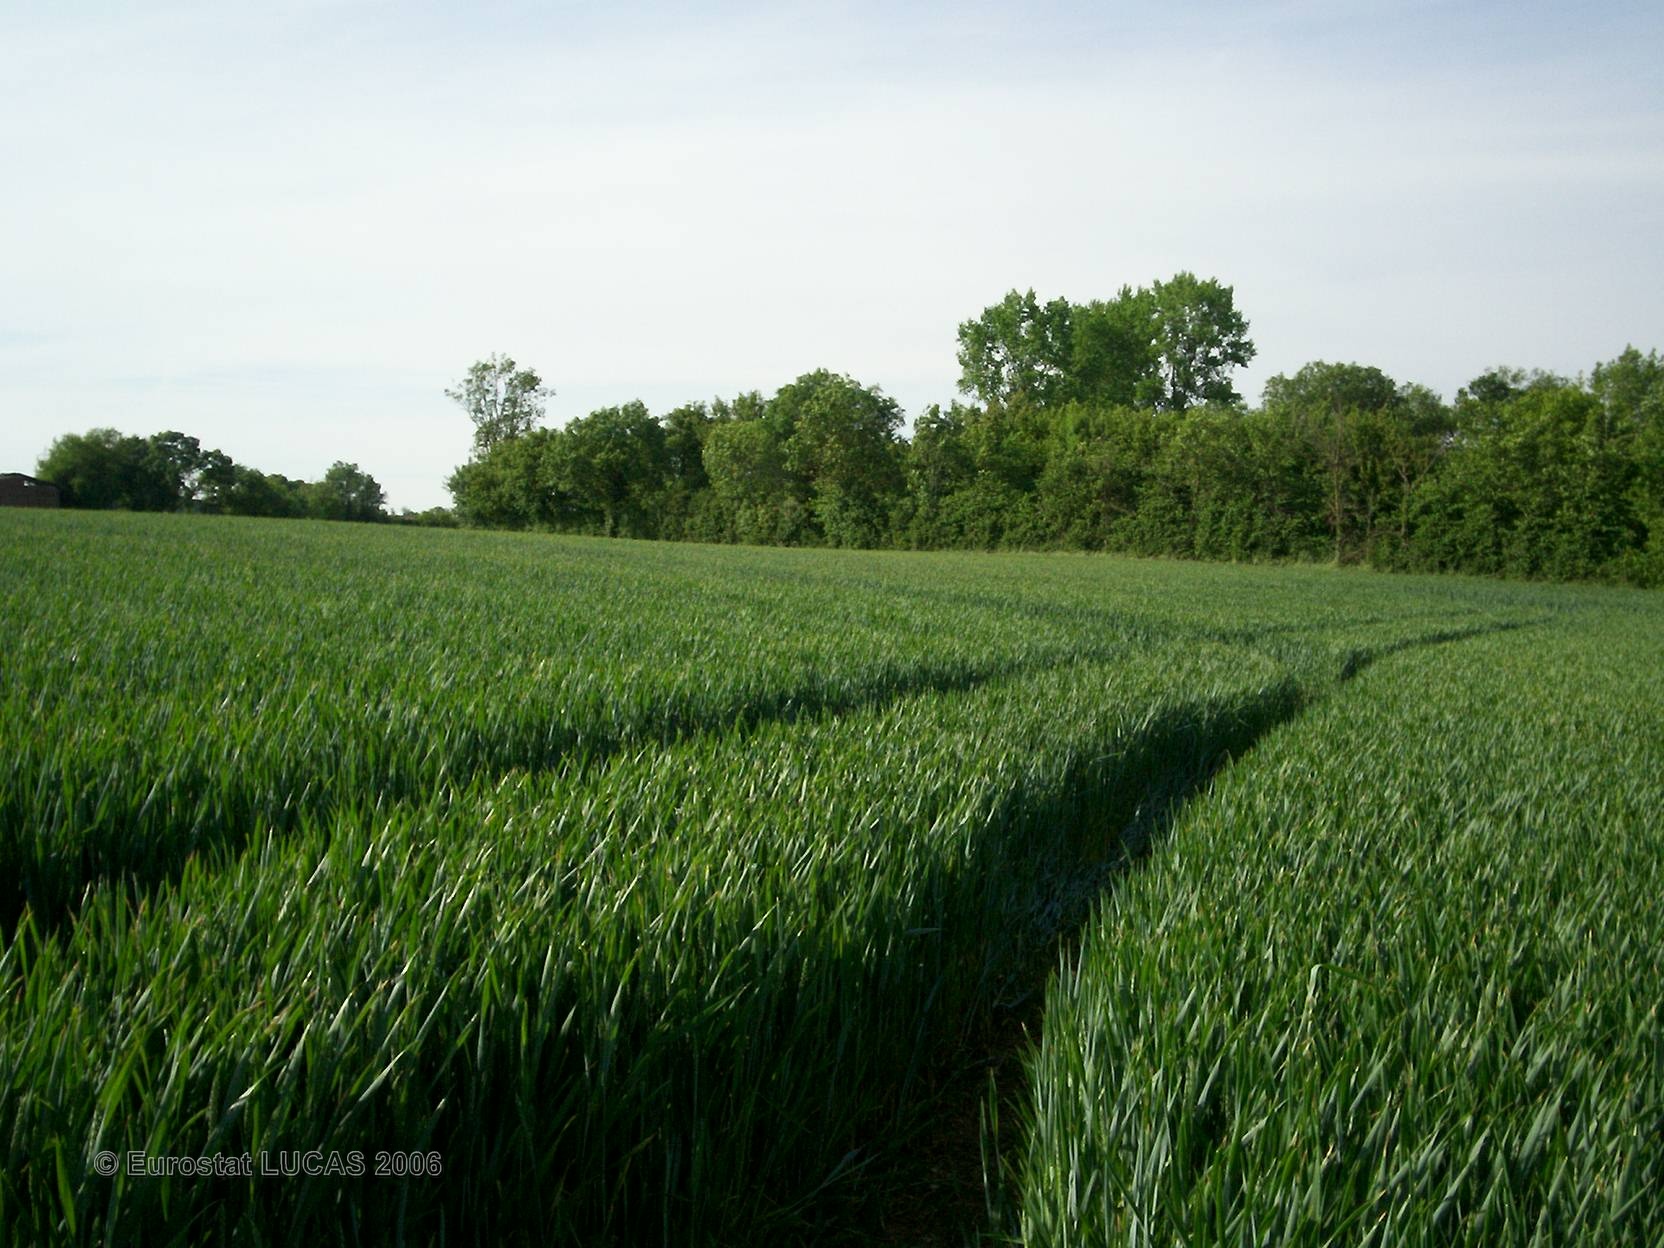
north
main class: Cropland
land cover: Common wheat
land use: Agriculture (excluding fallow land and kitchen gardens)
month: May
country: FR
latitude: 46.1184
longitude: -0.1796
